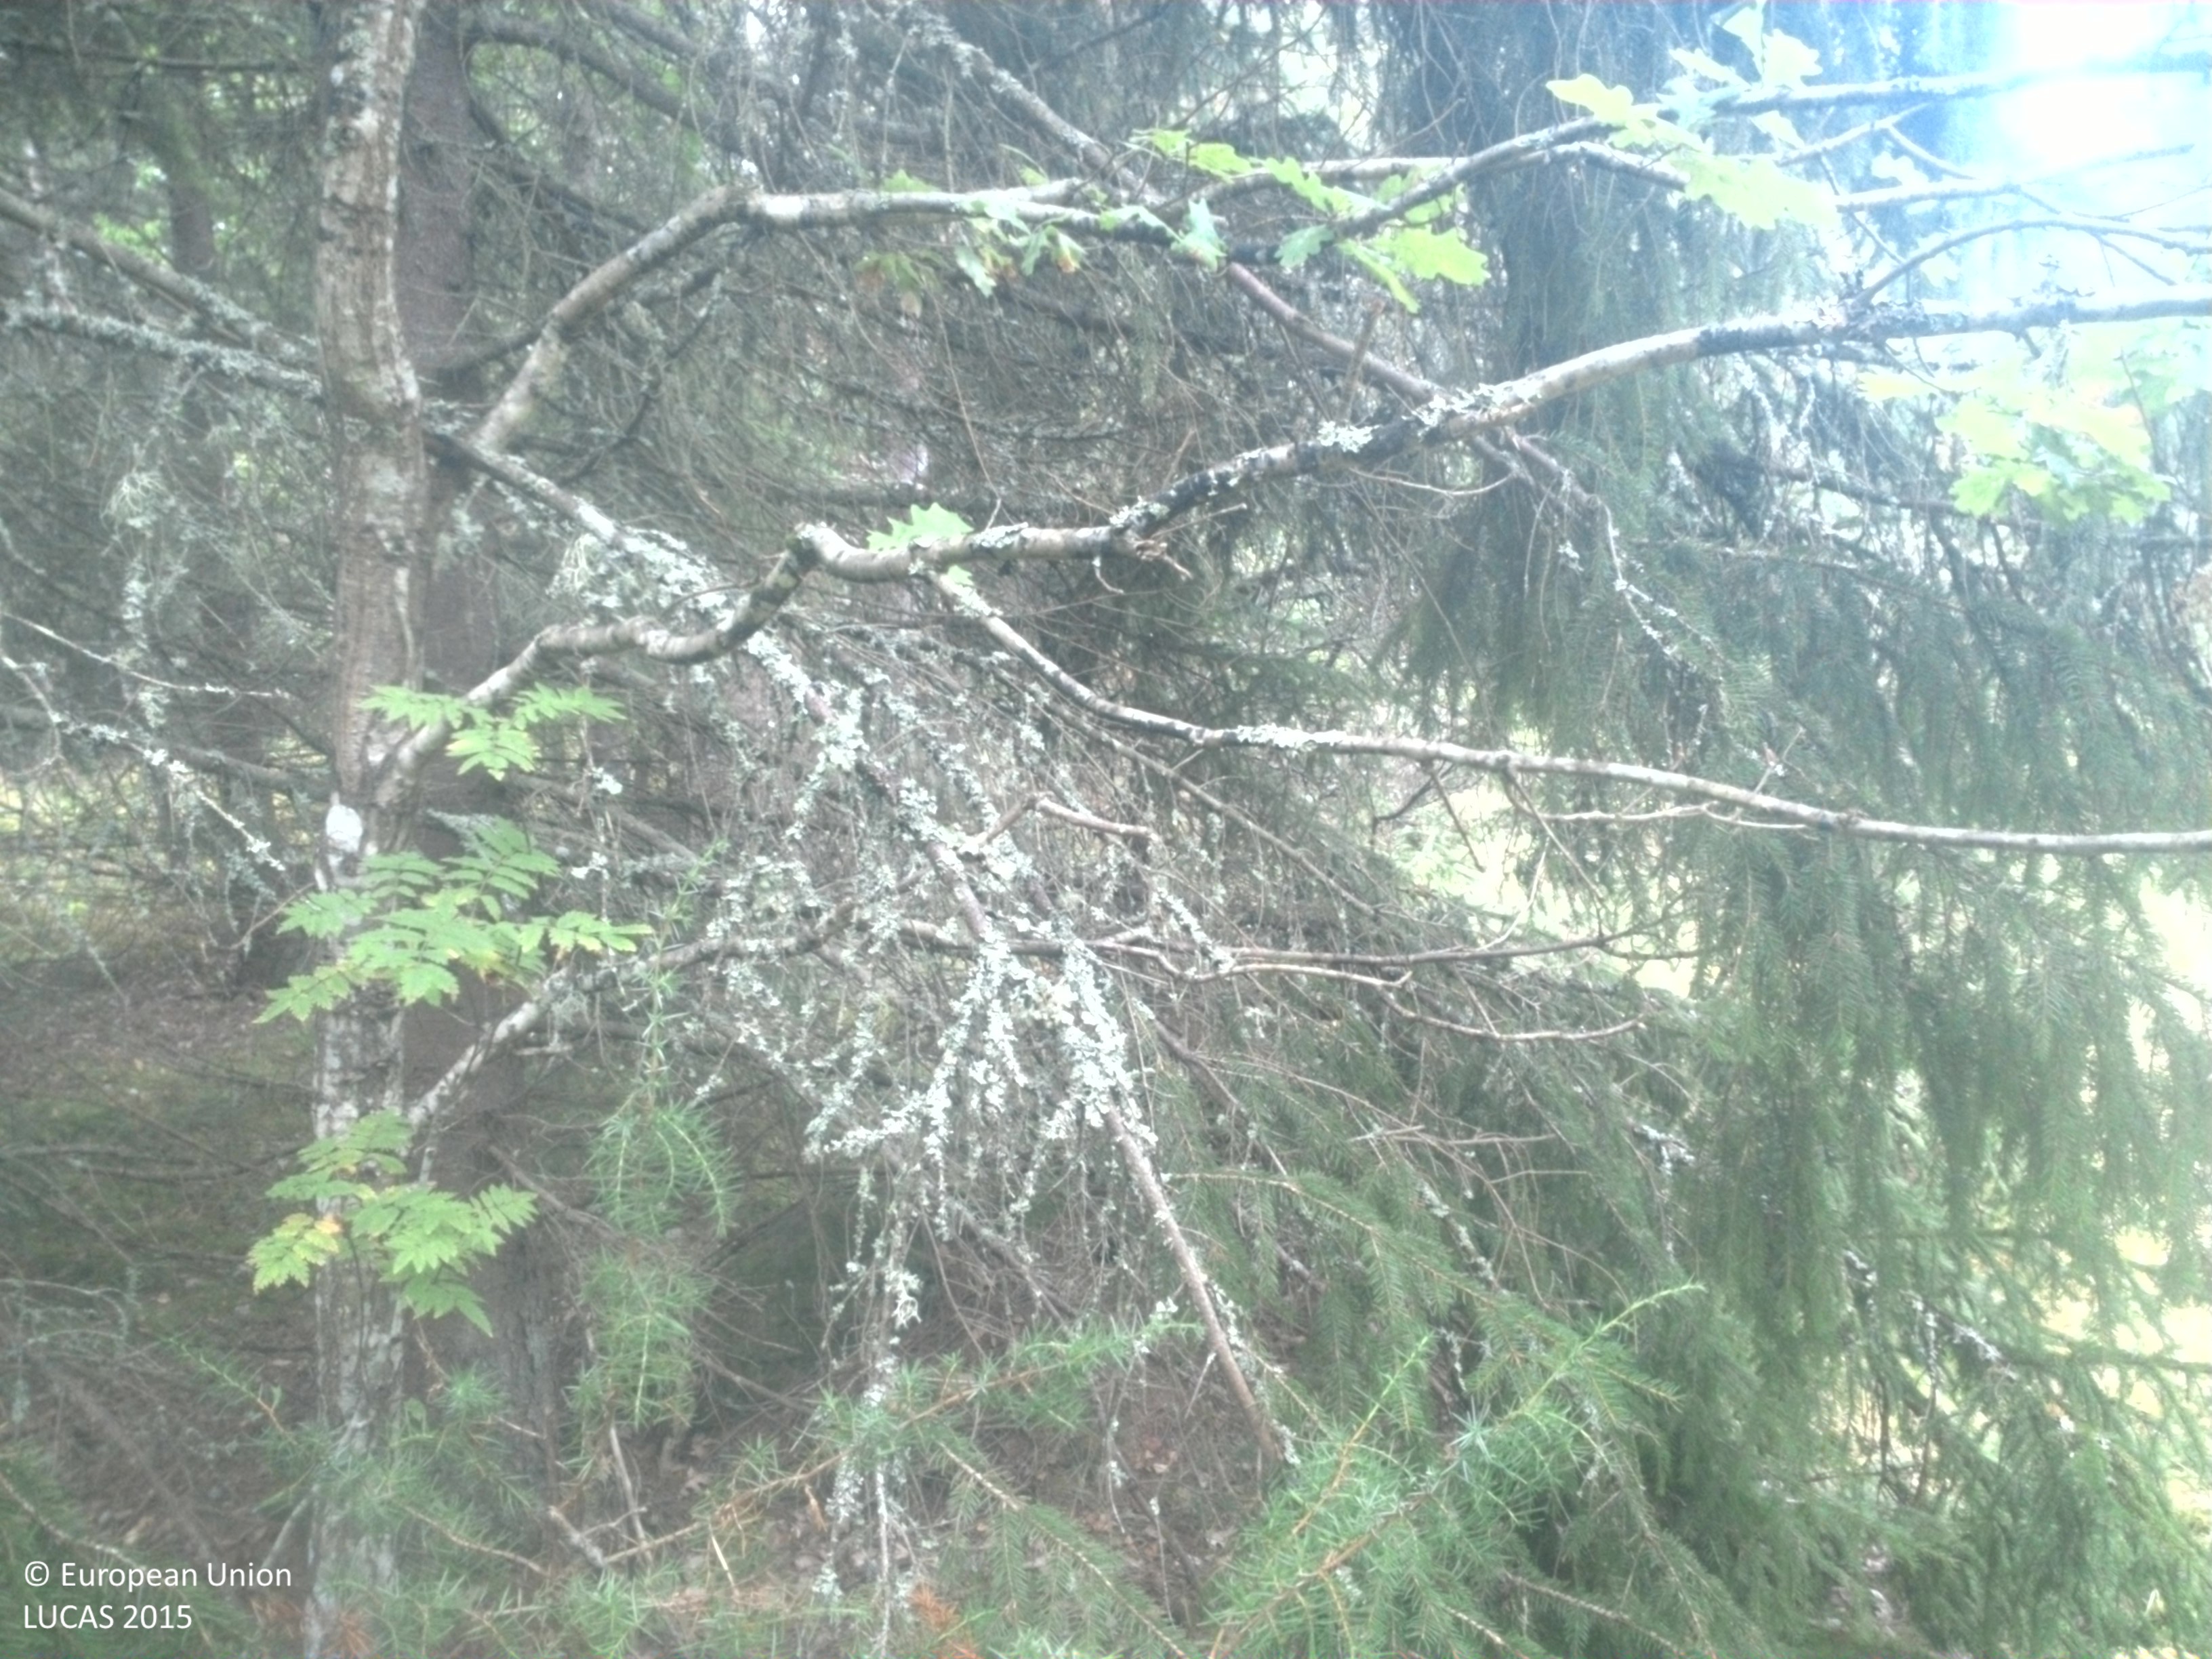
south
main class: Woodland
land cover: Spruce dominated coniferous woodland
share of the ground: 25 - 50 %
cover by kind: coniferous forest trees 35 %, herbaceous plants 30 %, lichens and mosses 30 %, broadleaved forest trees 5 %
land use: Forestry
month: September
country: SE
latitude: 58.8277
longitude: 13.9594
